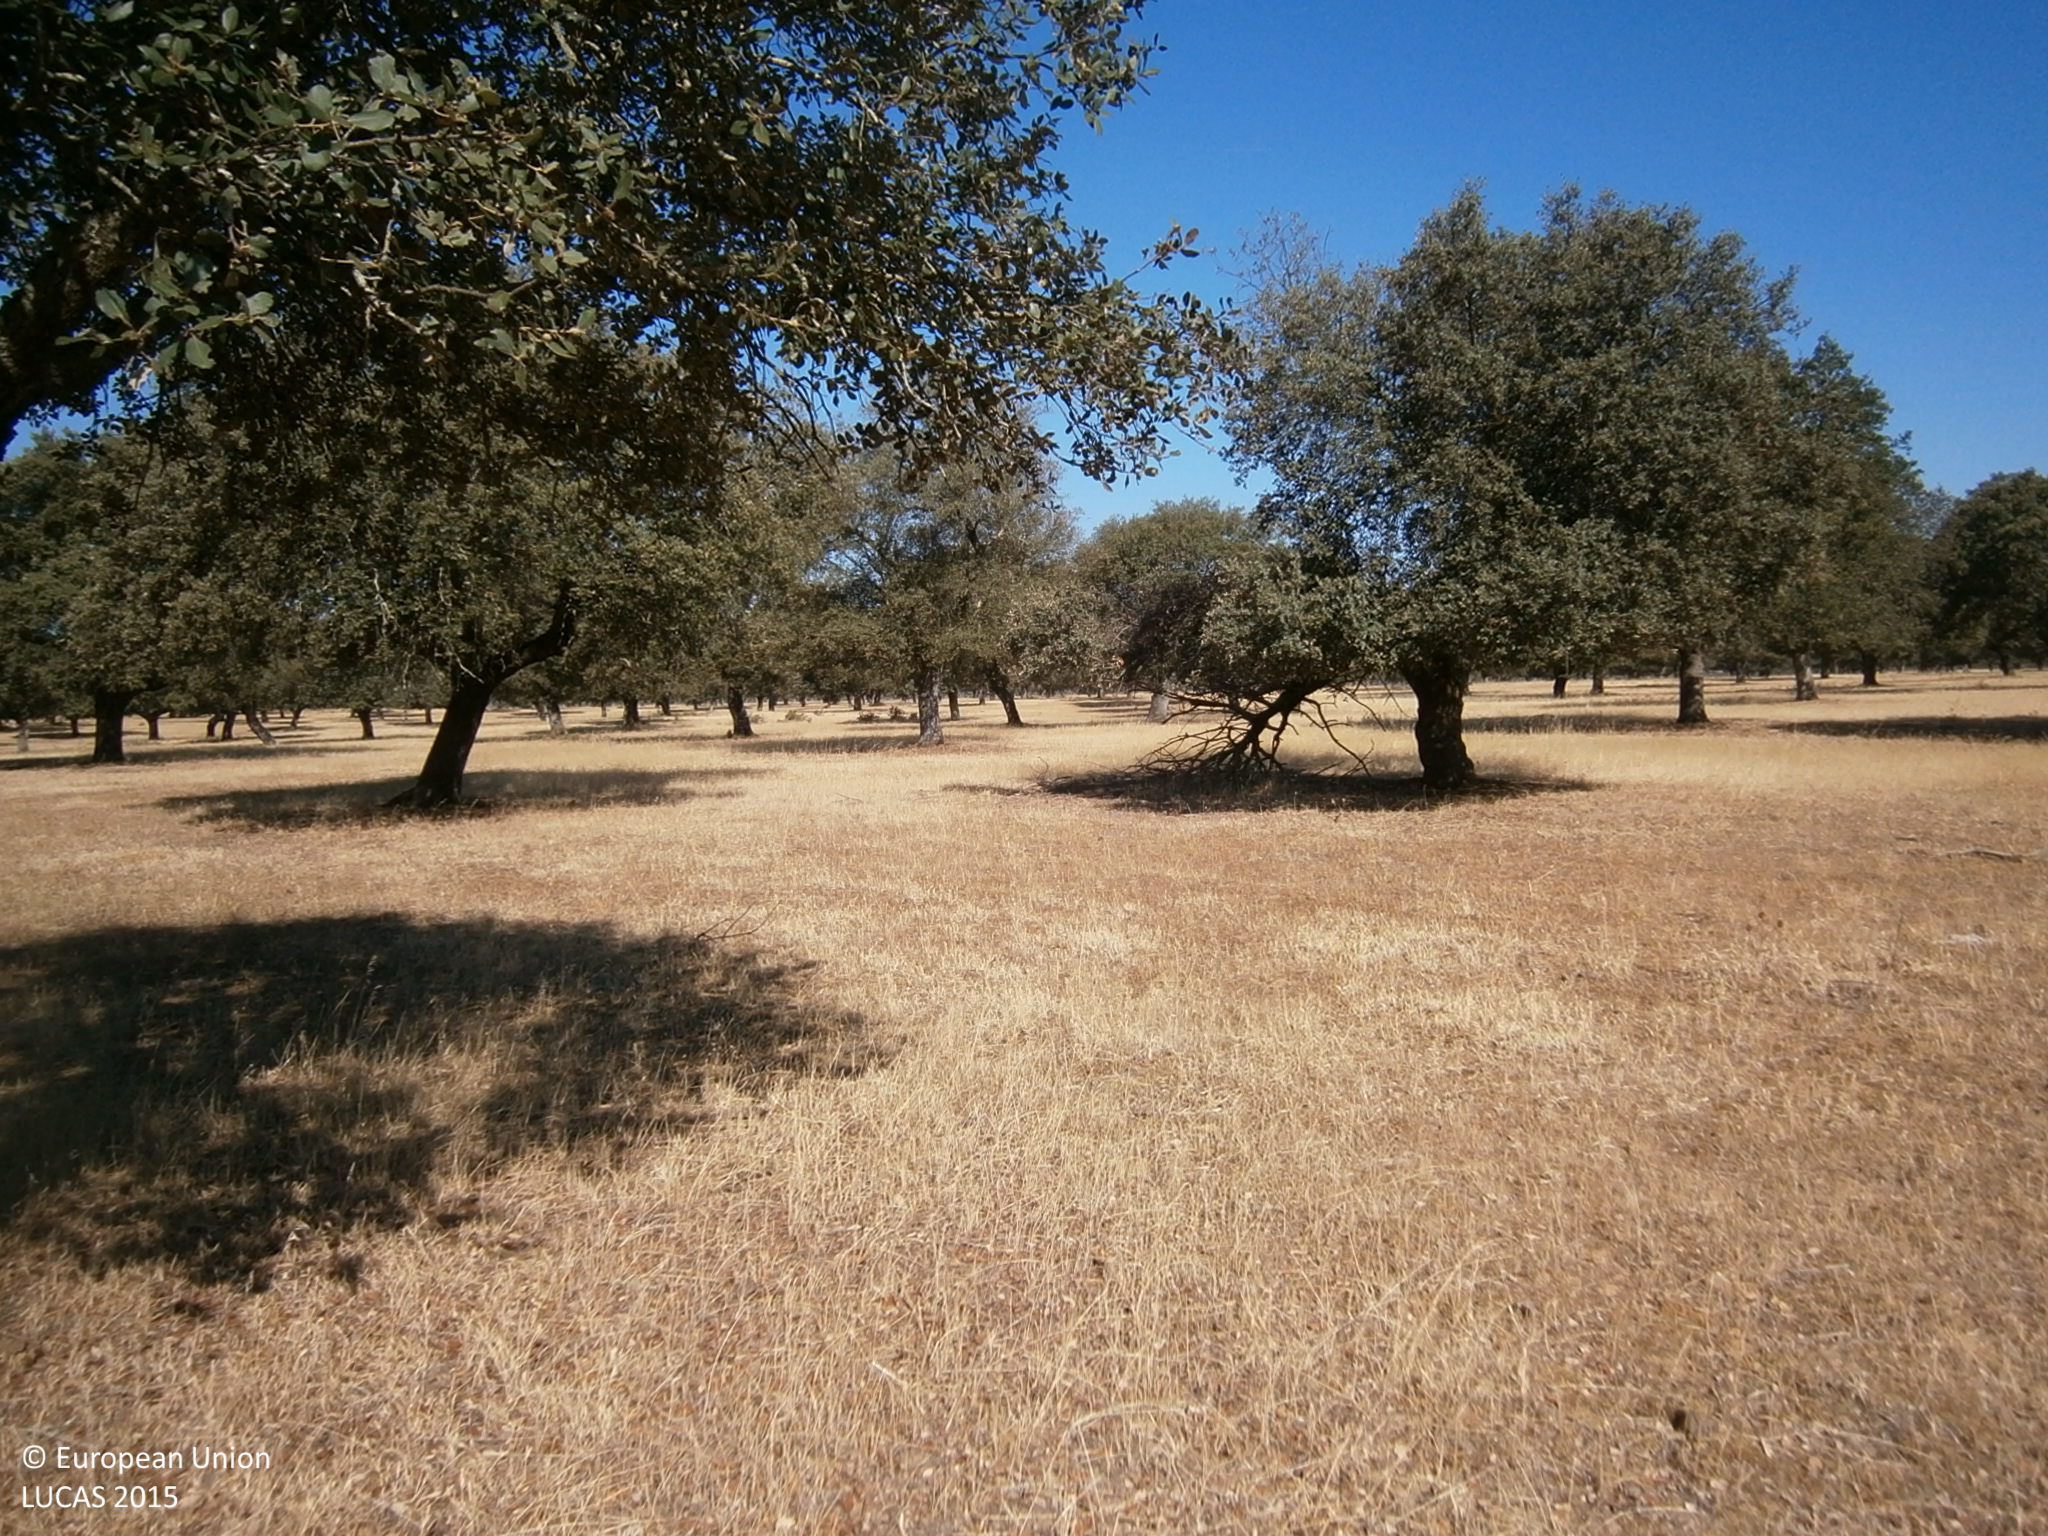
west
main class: Woodland
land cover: Broadleaved woodland
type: broadleaved evergreen forest
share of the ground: 25 - 50 %
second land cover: Spontaneously vegetated surfaces
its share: 50 - 75 %
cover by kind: broadleaved forest trees 40 %, herbaceous plants 40 %, unconsolidated bare surface 20 %
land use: Forestry
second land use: Agriculture (excluding fallow land and kitchen gardens)
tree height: > 5 m
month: July
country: ES
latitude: 38.9741
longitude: -6.7929
